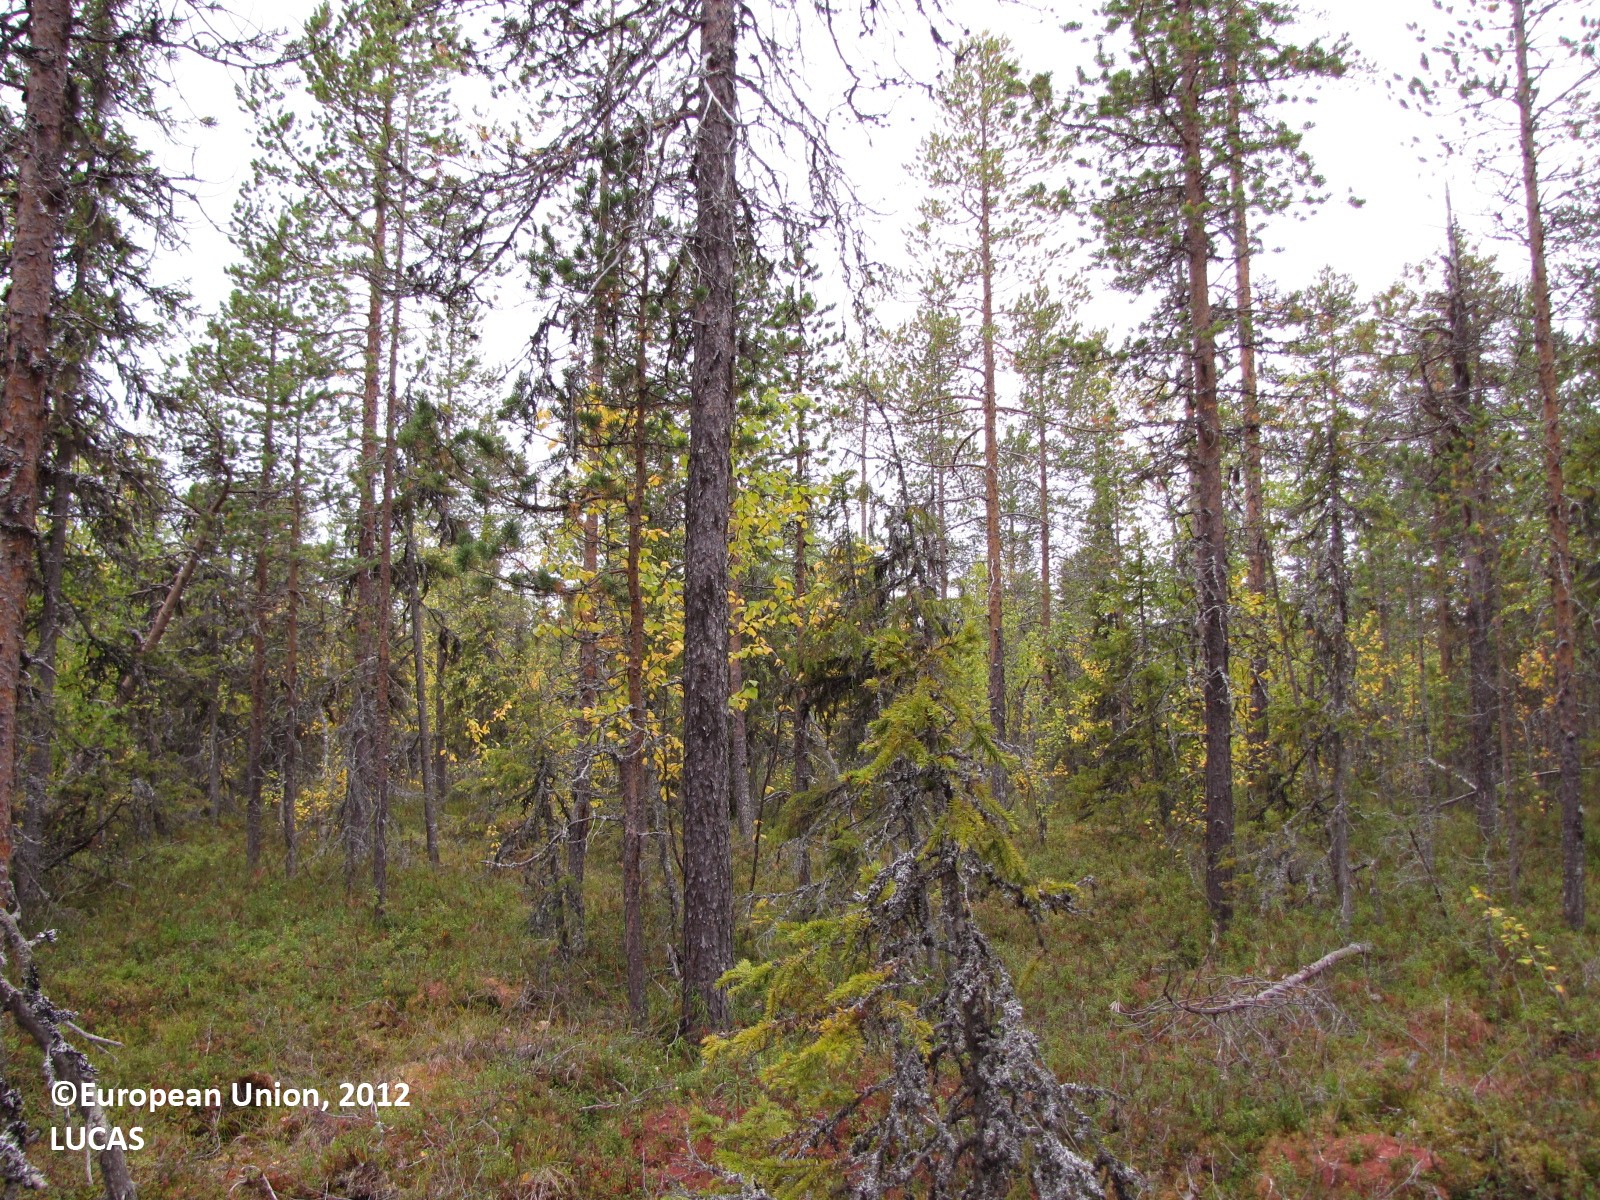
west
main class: Woodland
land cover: Pine dominated mixed woodland
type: boreal forest
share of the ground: 25 - 50 %
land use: Forestry
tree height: > 5 m
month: September
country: FI
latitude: 67.2299
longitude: 25.2129
